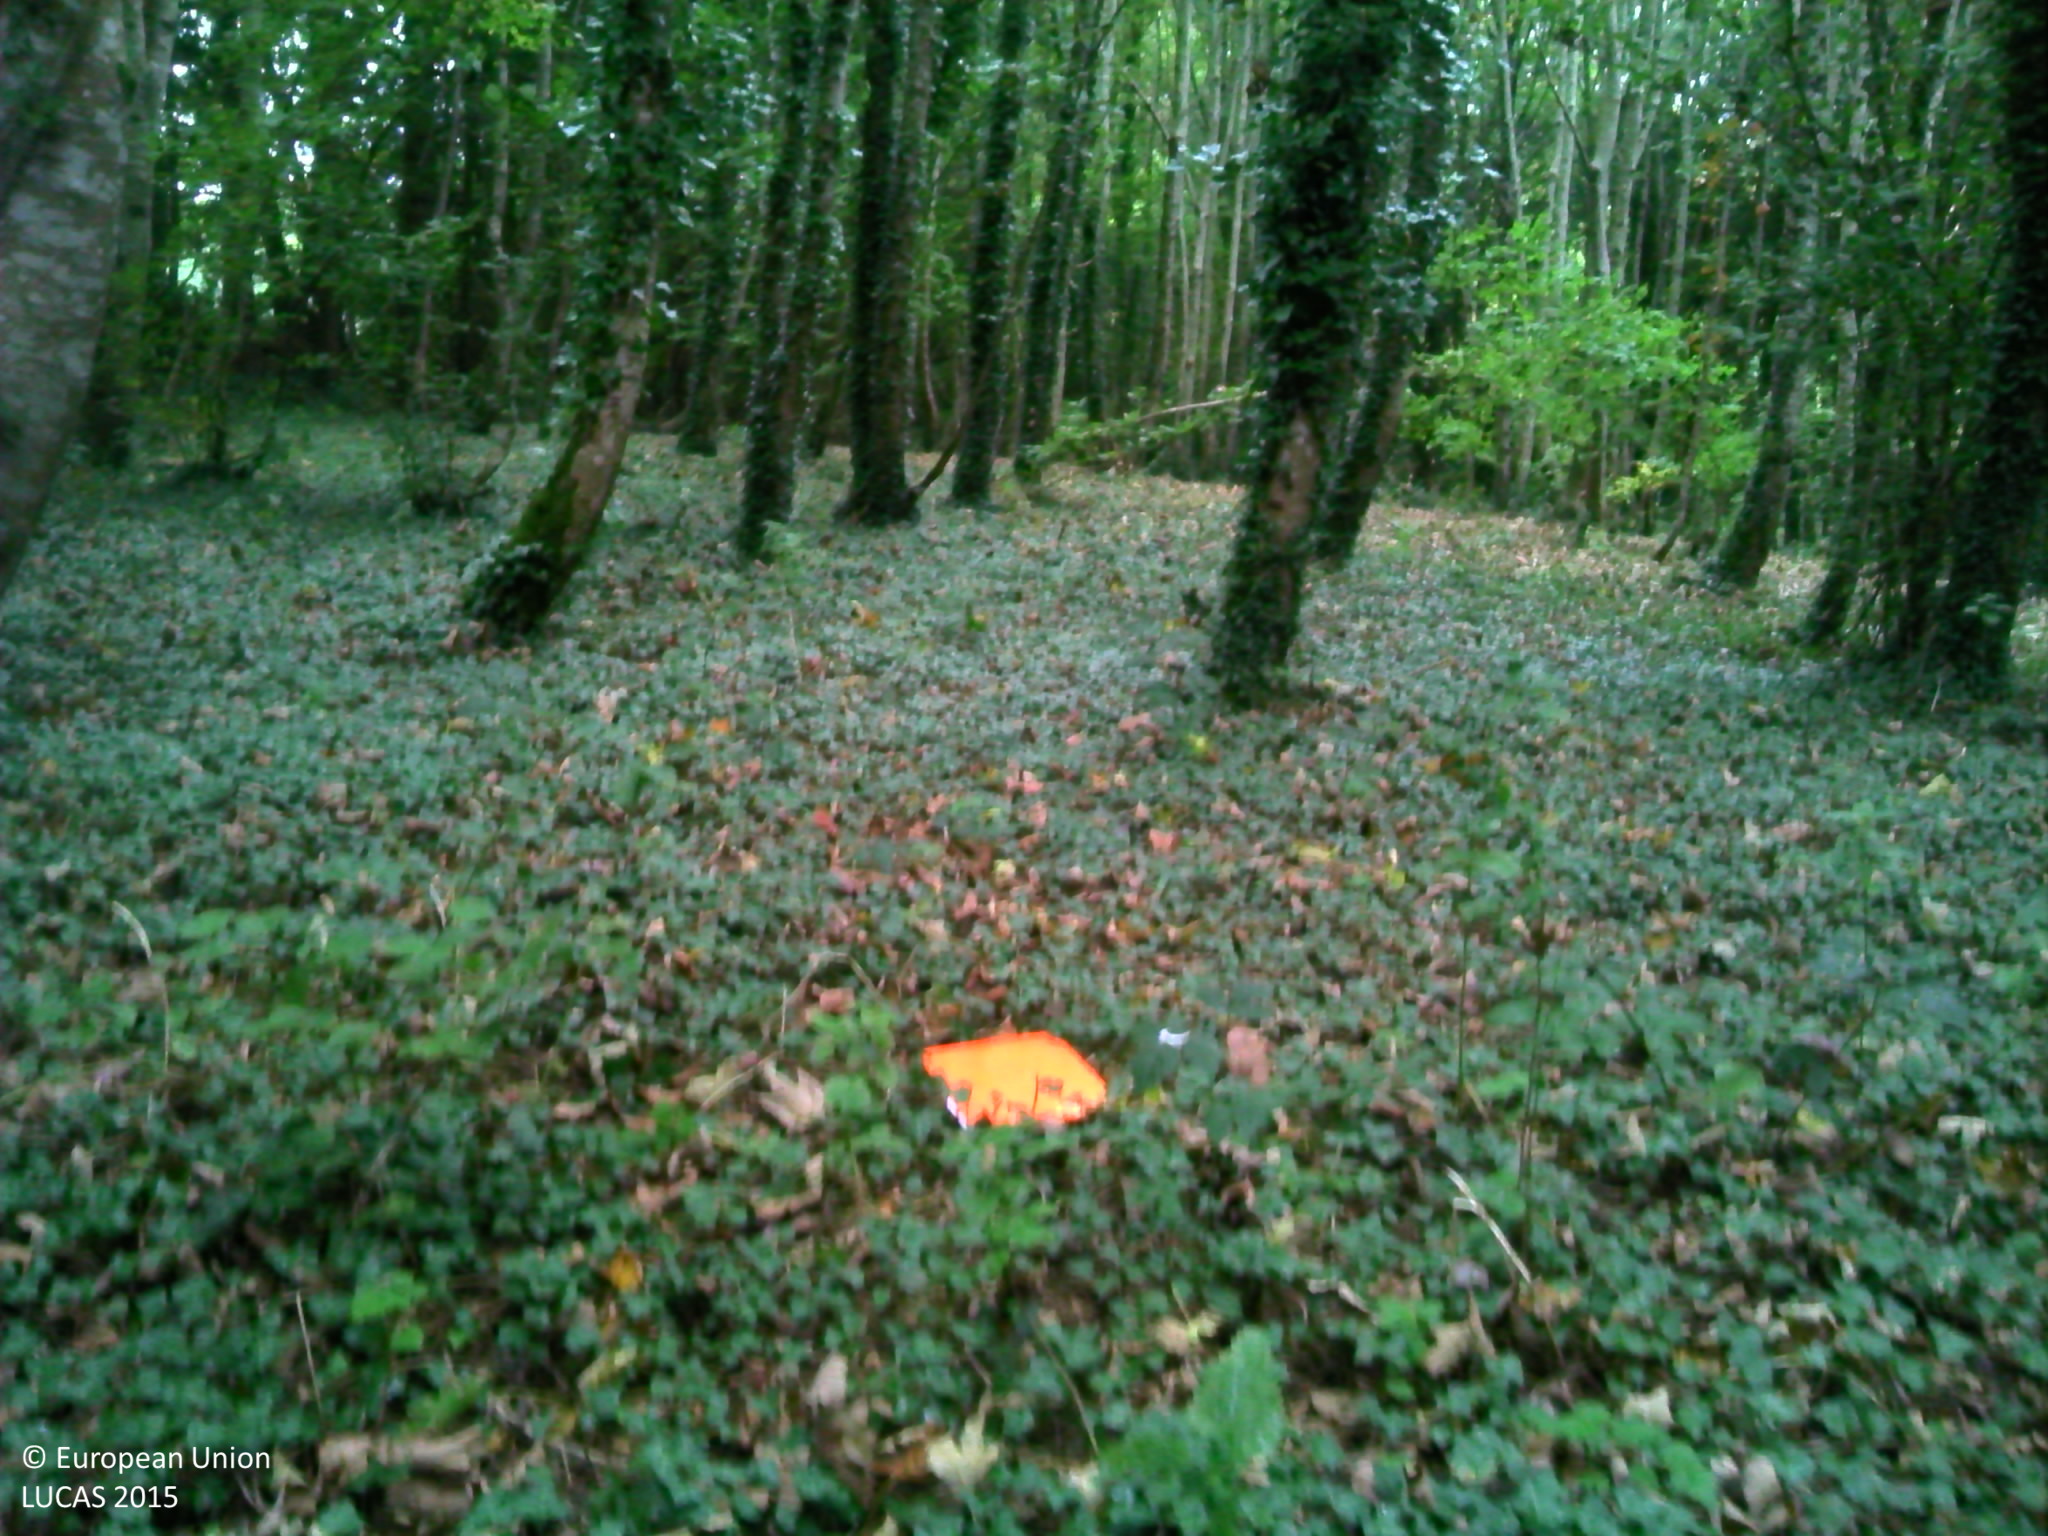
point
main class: Woodland
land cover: Broadleaved woodland
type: mesophytic deciduous forest
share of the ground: > 75 %
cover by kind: broadleaved forest trees 95 %, herbaceous plants 5 %
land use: Forestry
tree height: > 5 m
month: October
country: FR
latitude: 48.5408
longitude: -3.4742
